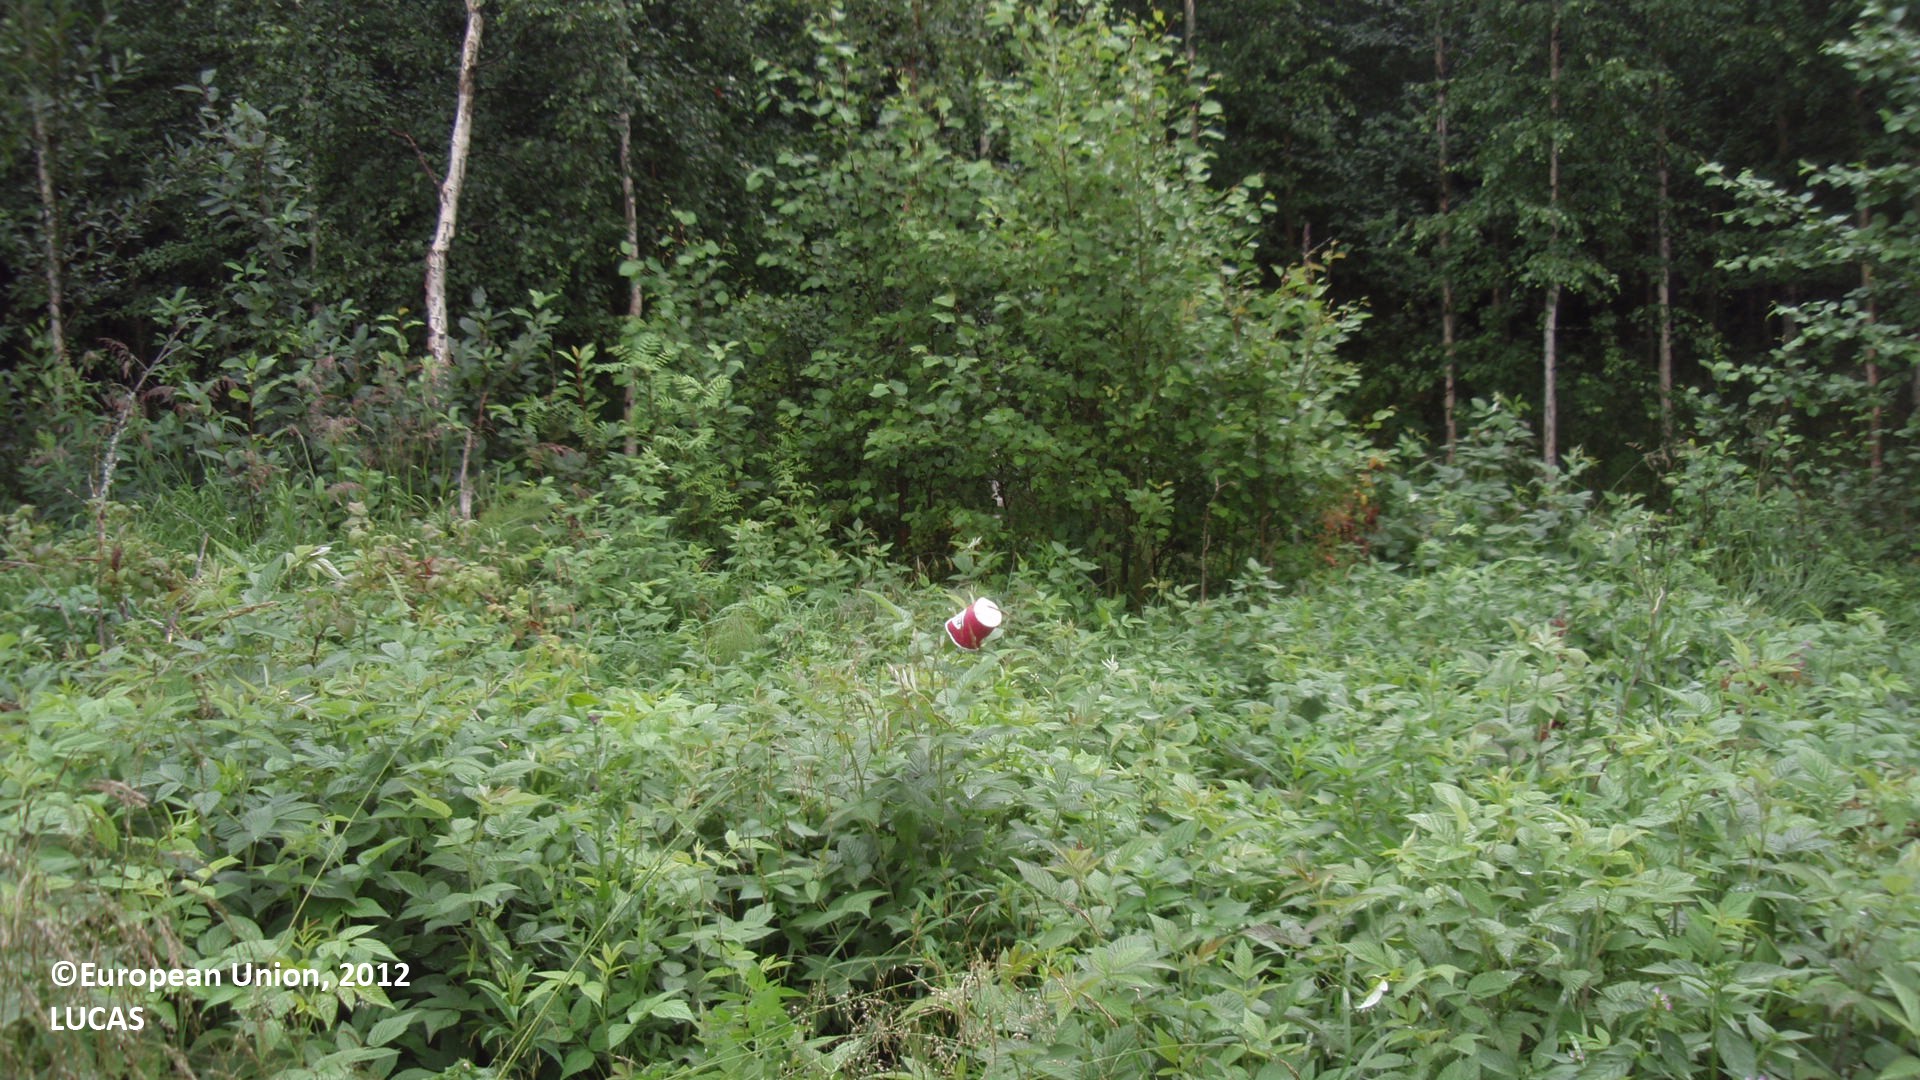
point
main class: Shrubland
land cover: Shrubland with sparse tree cover
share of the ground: > 75 %
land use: Fallow land
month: July
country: FI
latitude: 61.1521
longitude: 28.6327
